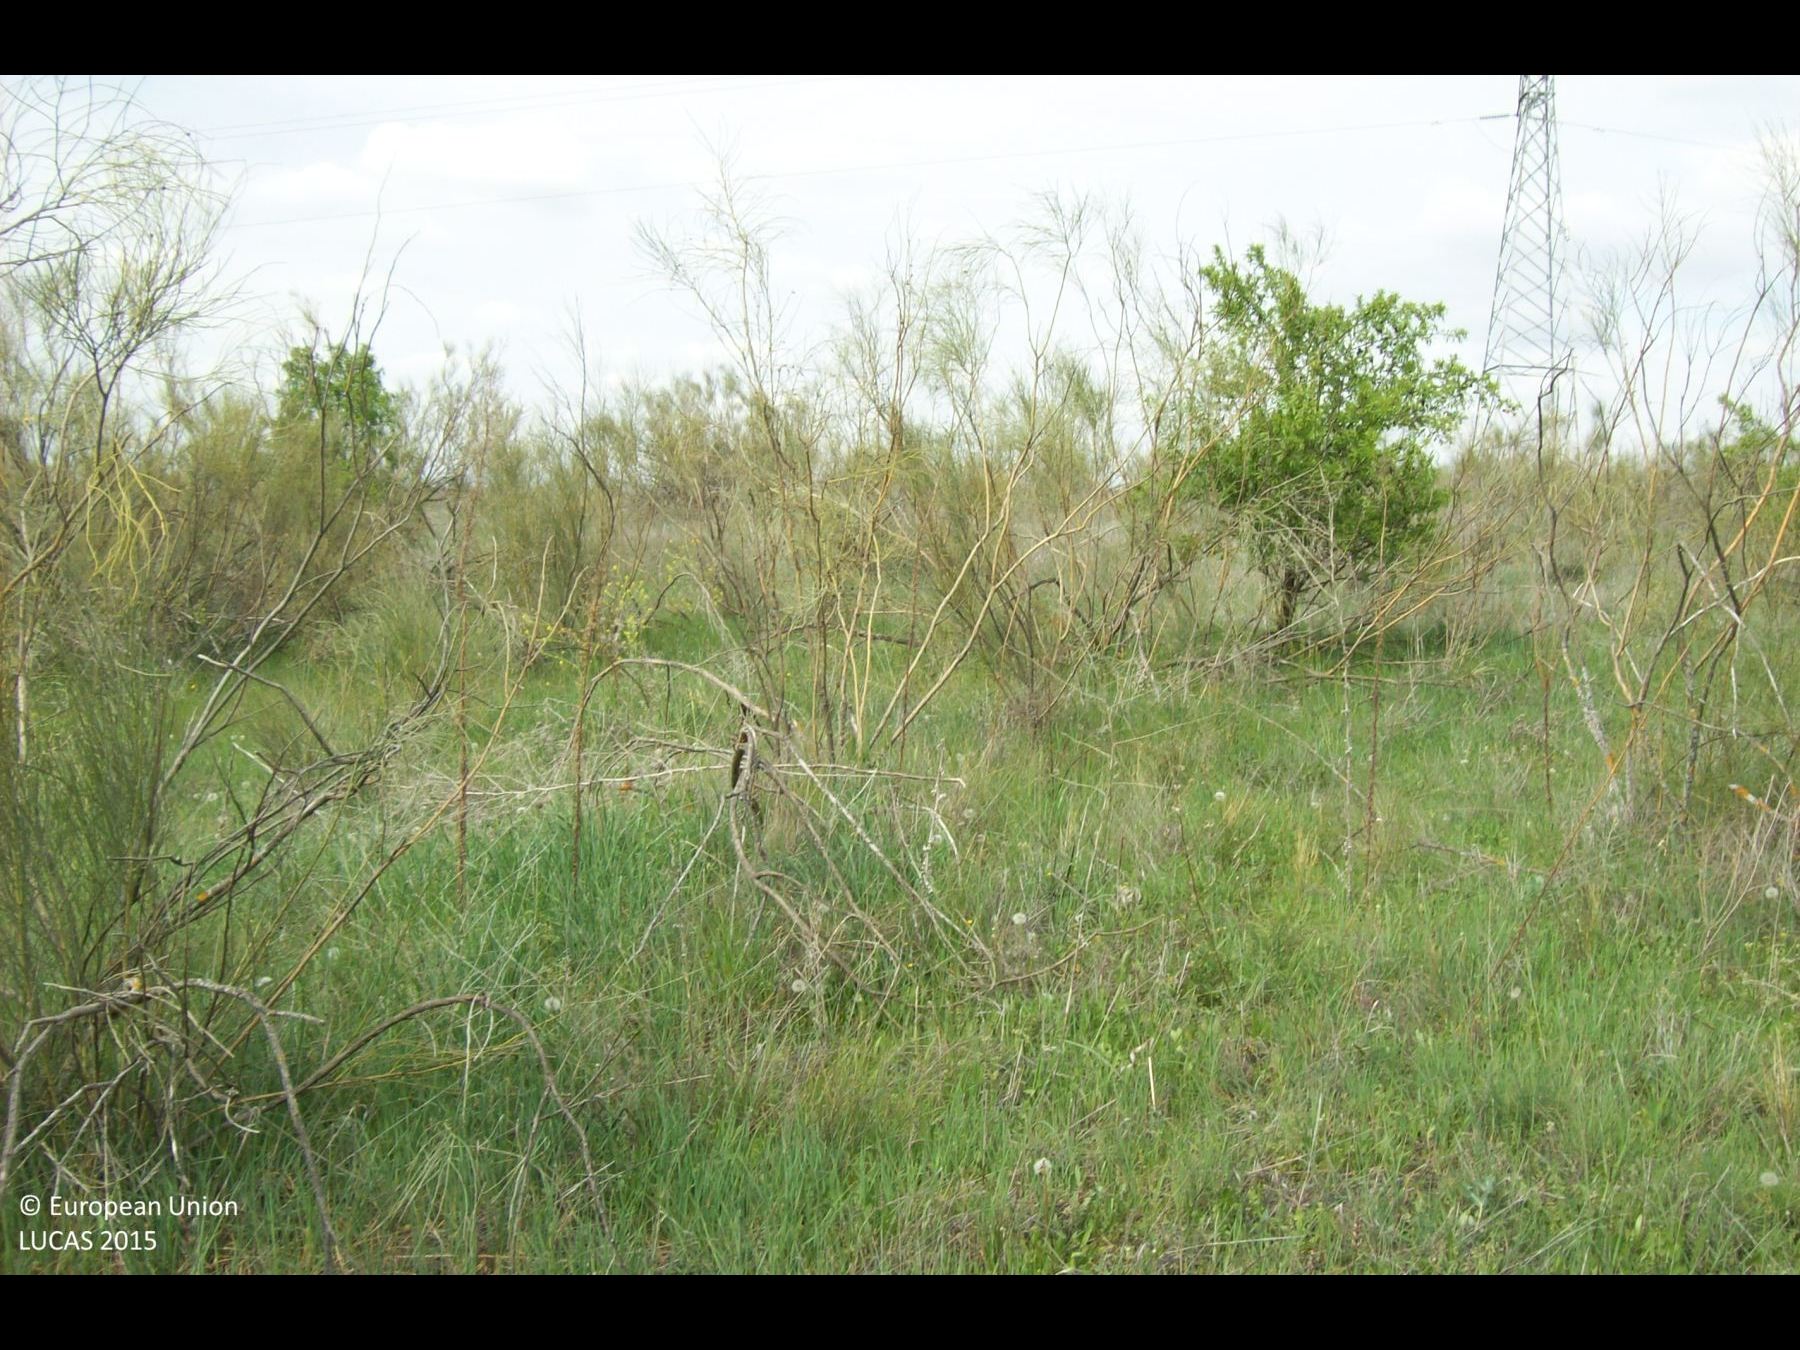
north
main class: Shrubland
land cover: Shrubland without tree cover
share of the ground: > 75 %
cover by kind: shrubs 50 %, herbaceous plants 50 %
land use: Semi-natural and natural areas not in use
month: April
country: ES
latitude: 40.4784
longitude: -3.9252
